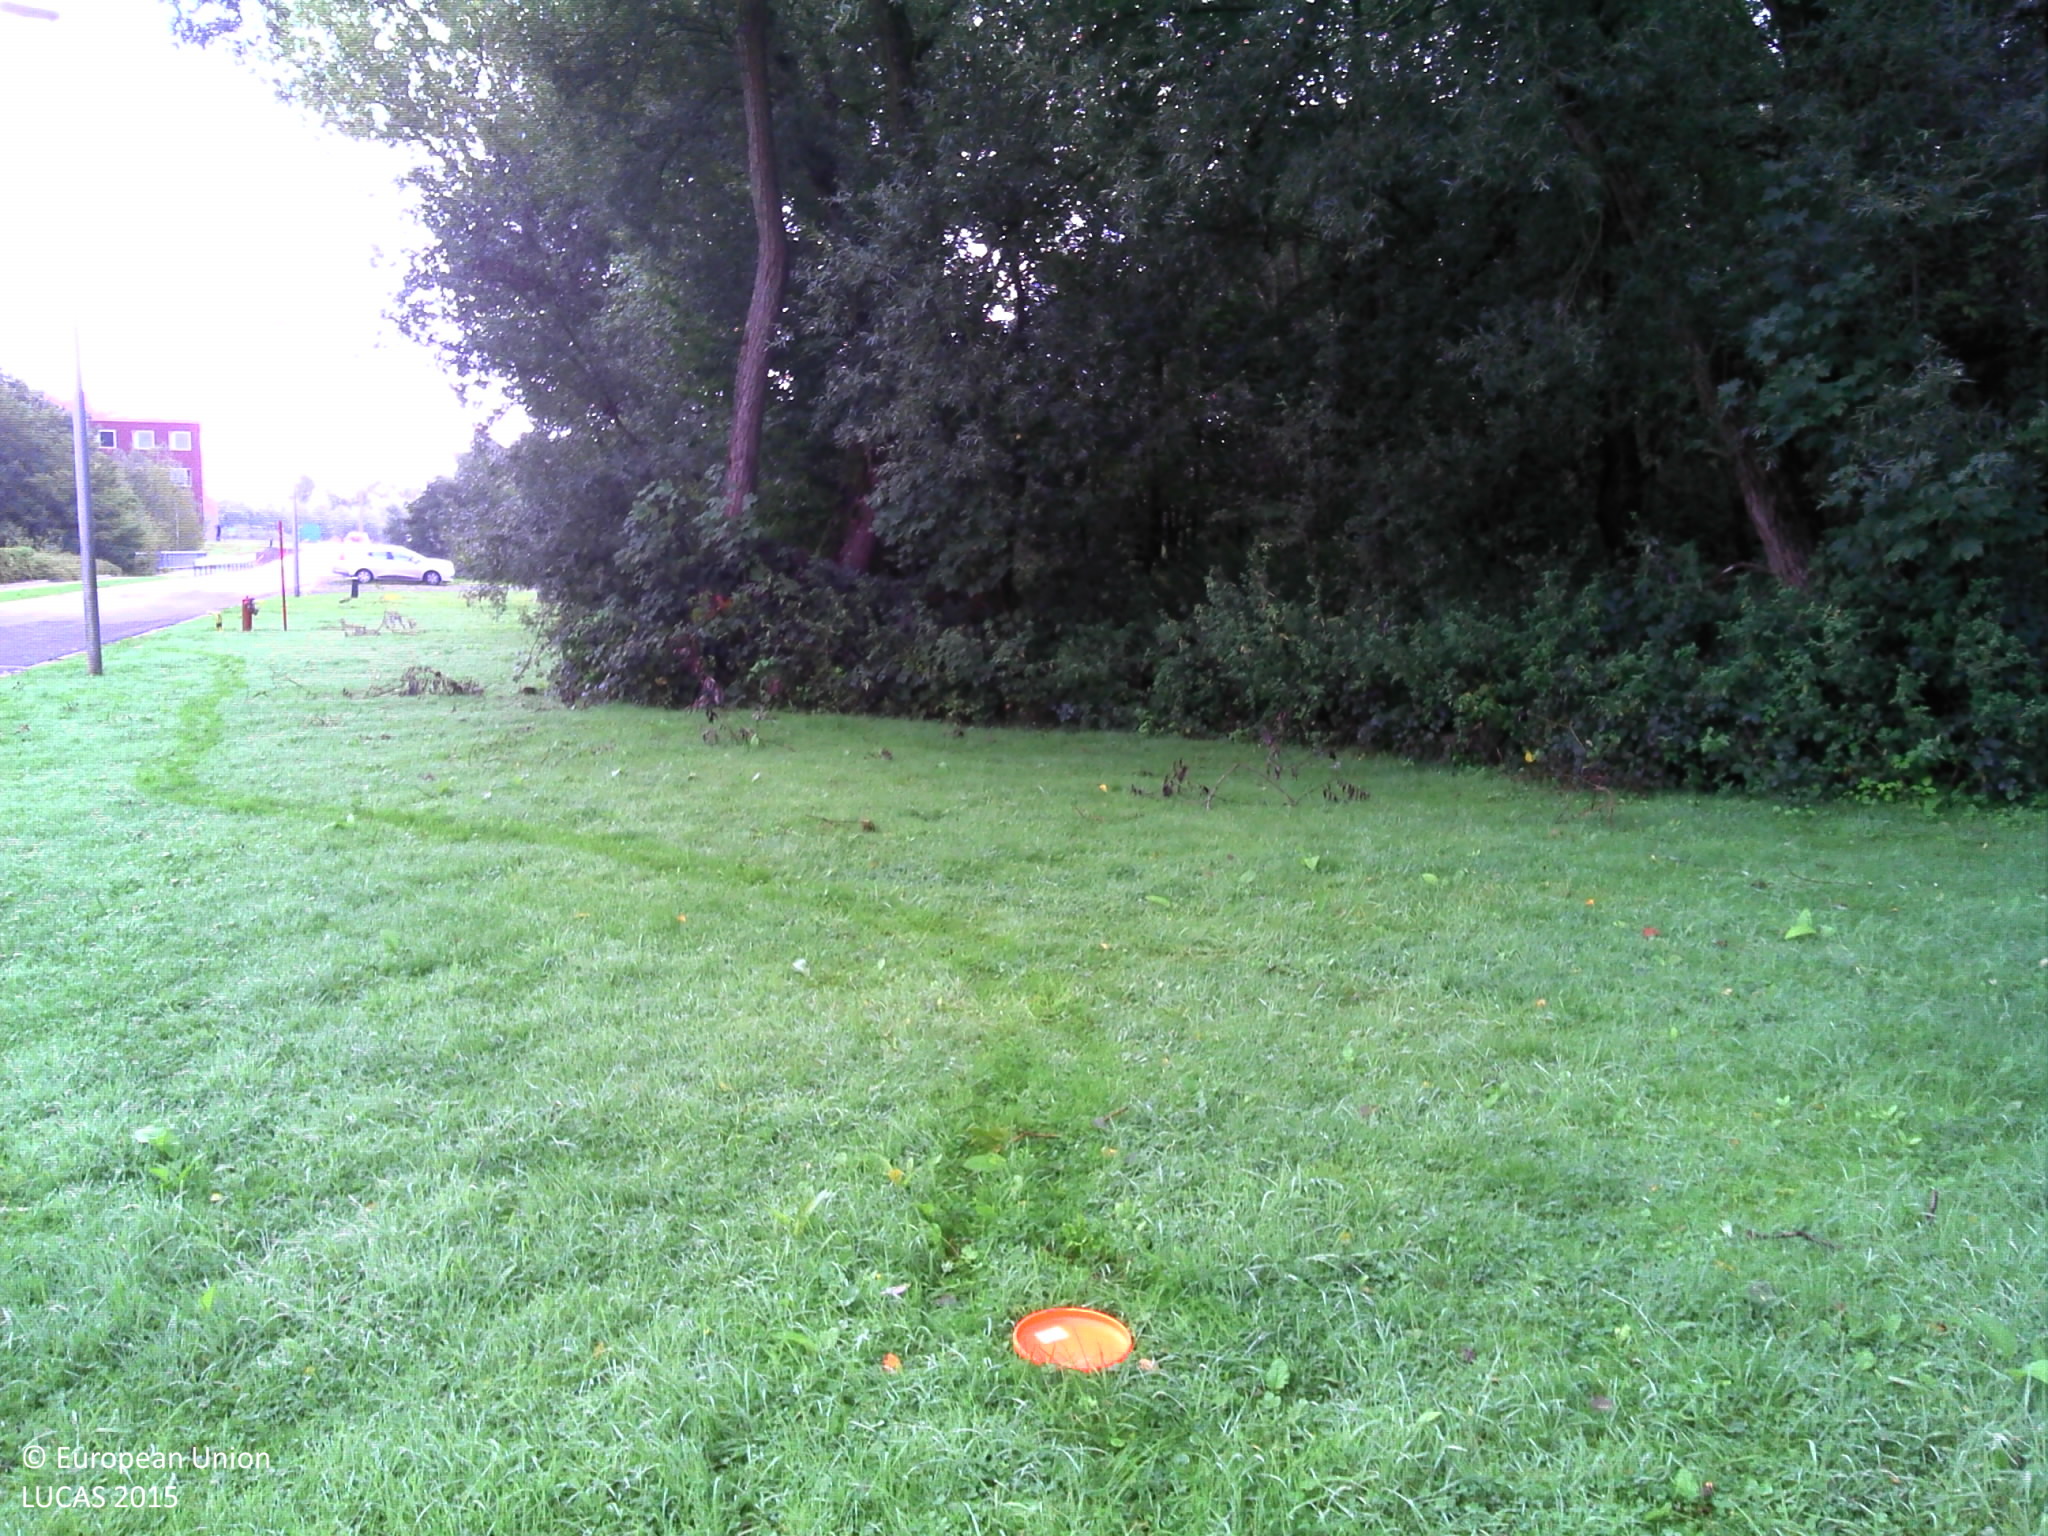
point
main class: Grassland
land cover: Grassland without tree/shrub cover
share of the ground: > 75 %
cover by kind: herbaceous plants 100 %
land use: Road transport
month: September
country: BE
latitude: 51.1078
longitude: 4.3536
